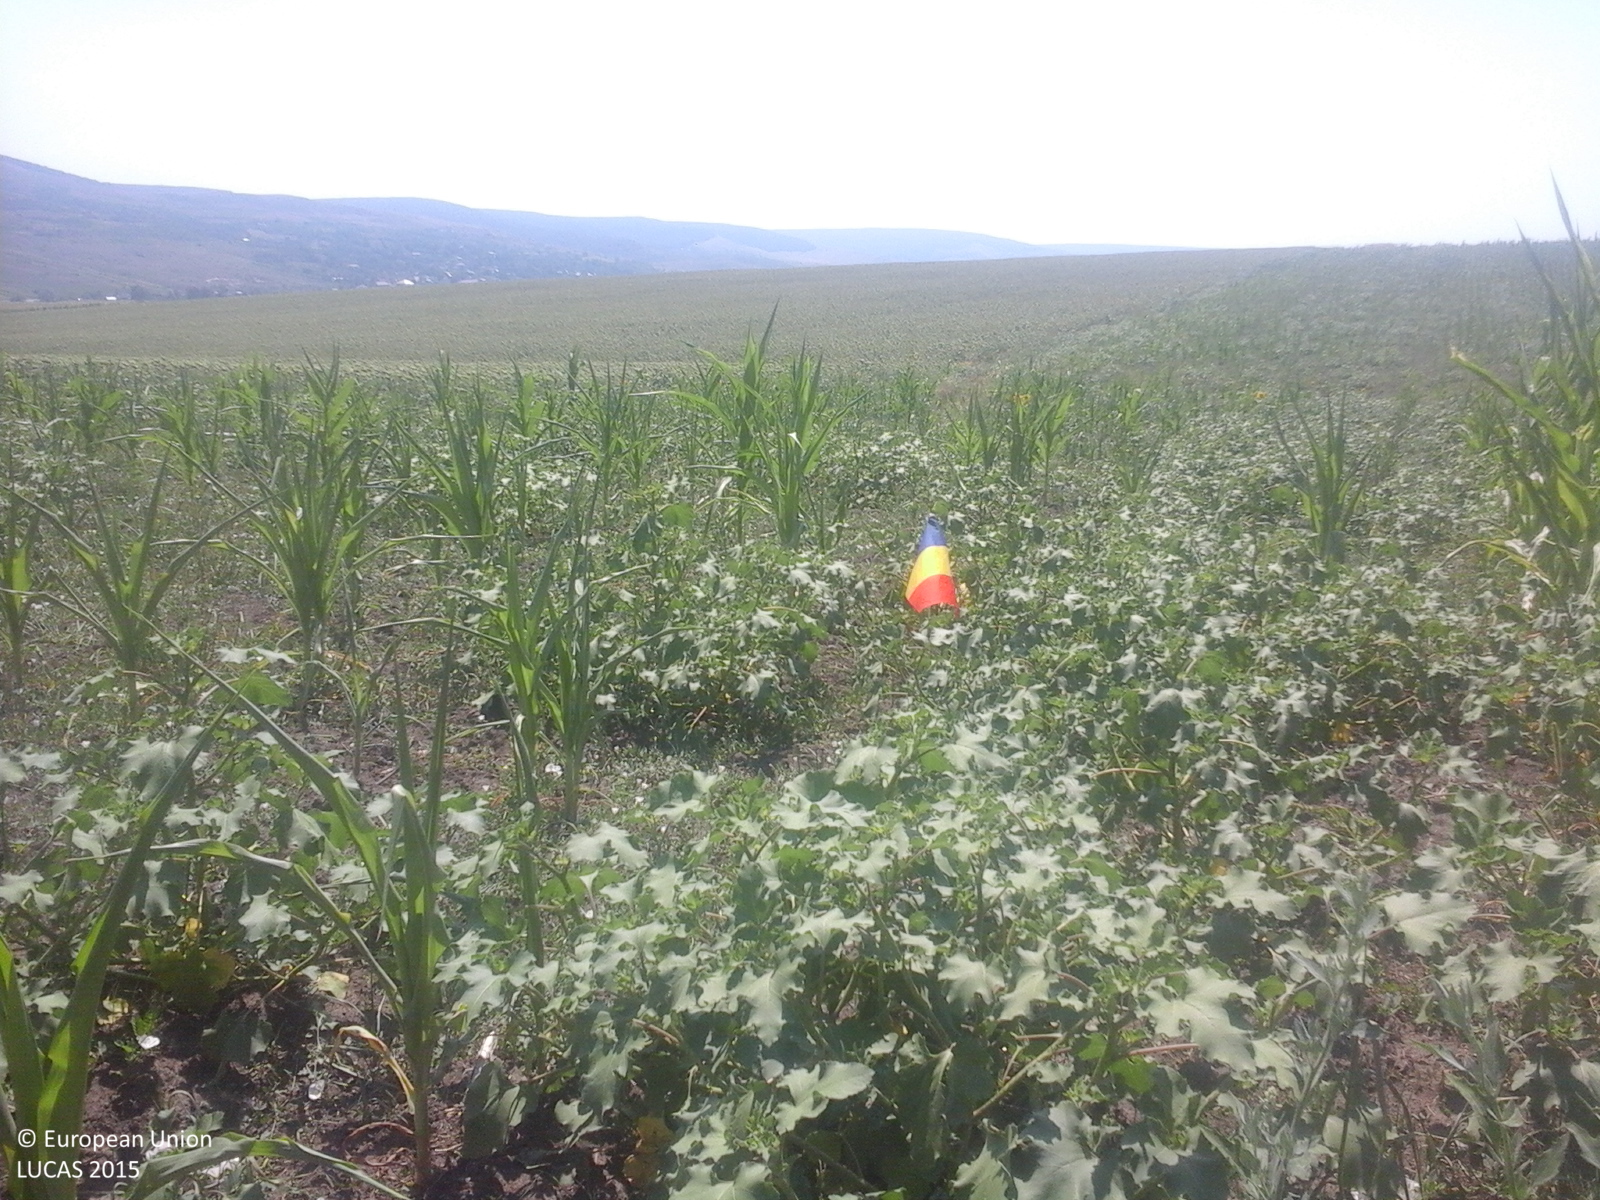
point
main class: Cropland
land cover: Maize
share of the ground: 50 - 75 %
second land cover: Spontaneously vegetated surfaces
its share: 25 - 50 %
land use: Agriculture (excluding fallow land and kitchen gardens)
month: July
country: RO
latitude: 46.6575
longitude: 27.9644
